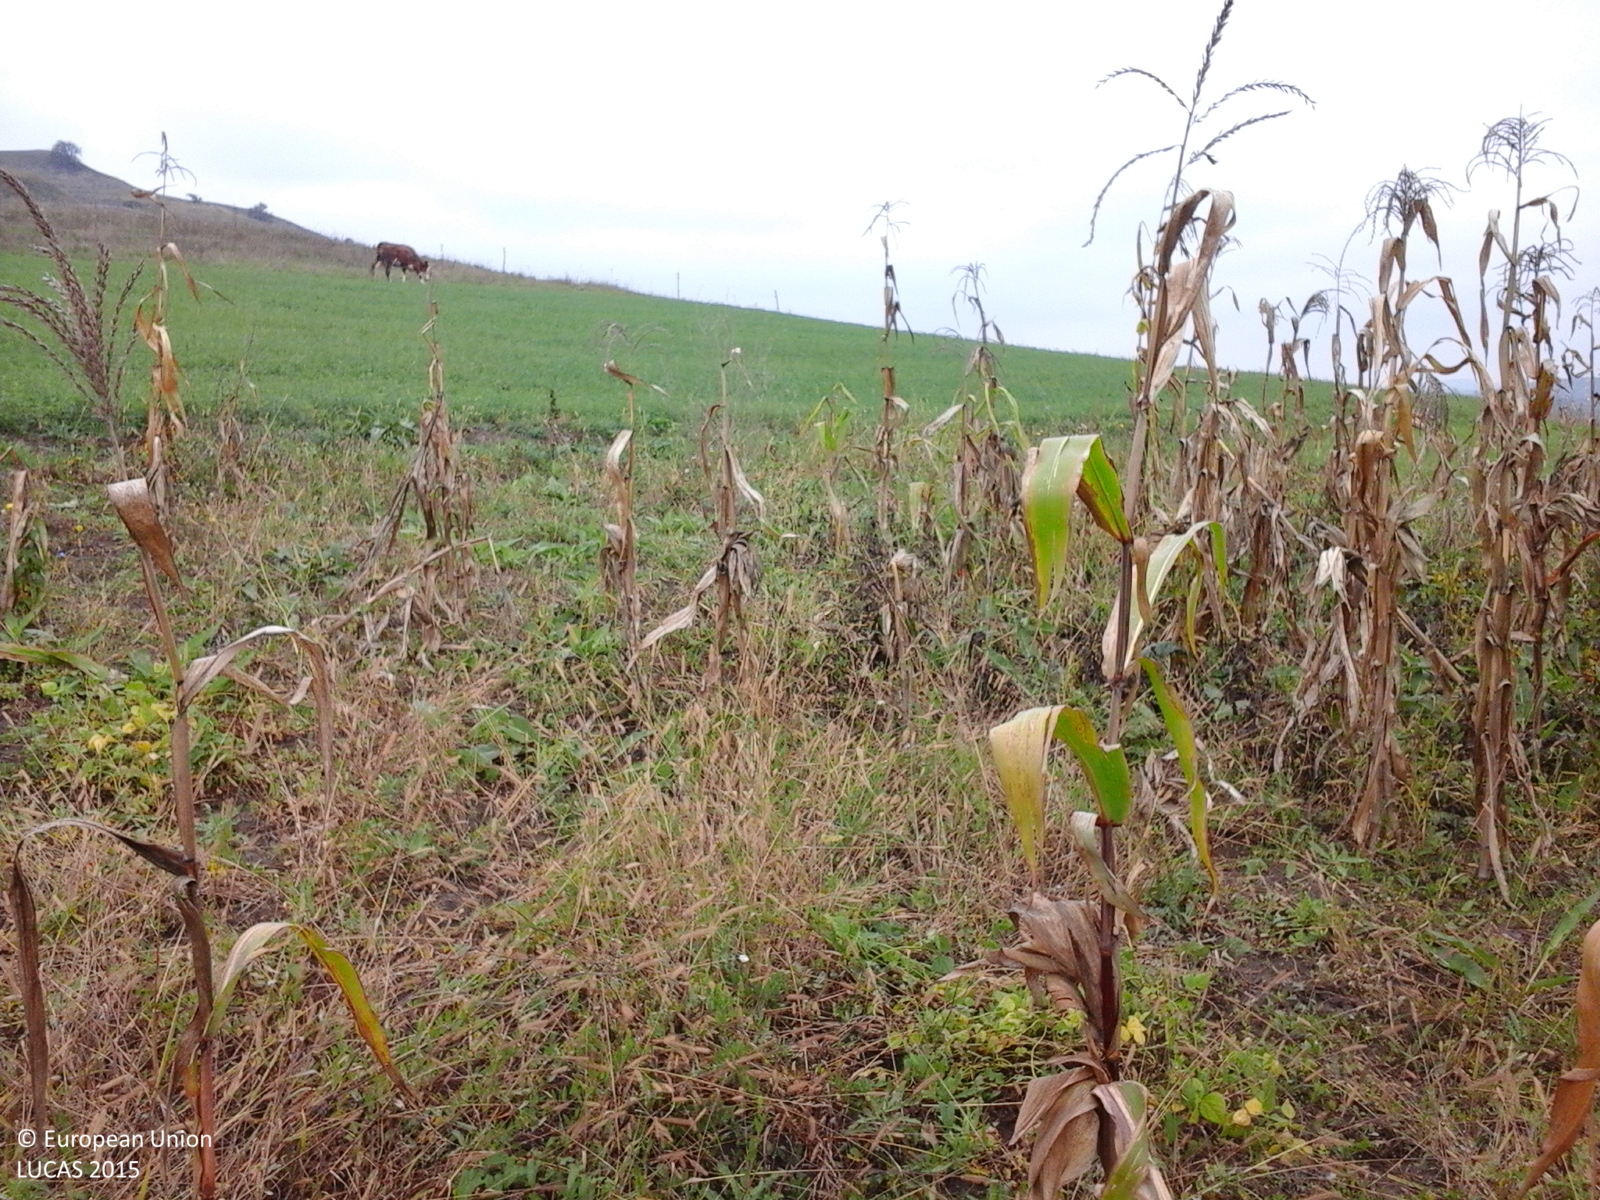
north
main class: Cropland
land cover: Maize
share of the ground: 25 - 50 %
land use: Agriculture (excluding fallow land and kitchen gardens)
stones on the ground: < 10 %
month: October
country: RO
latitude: 46.2669
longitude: 24.9244
